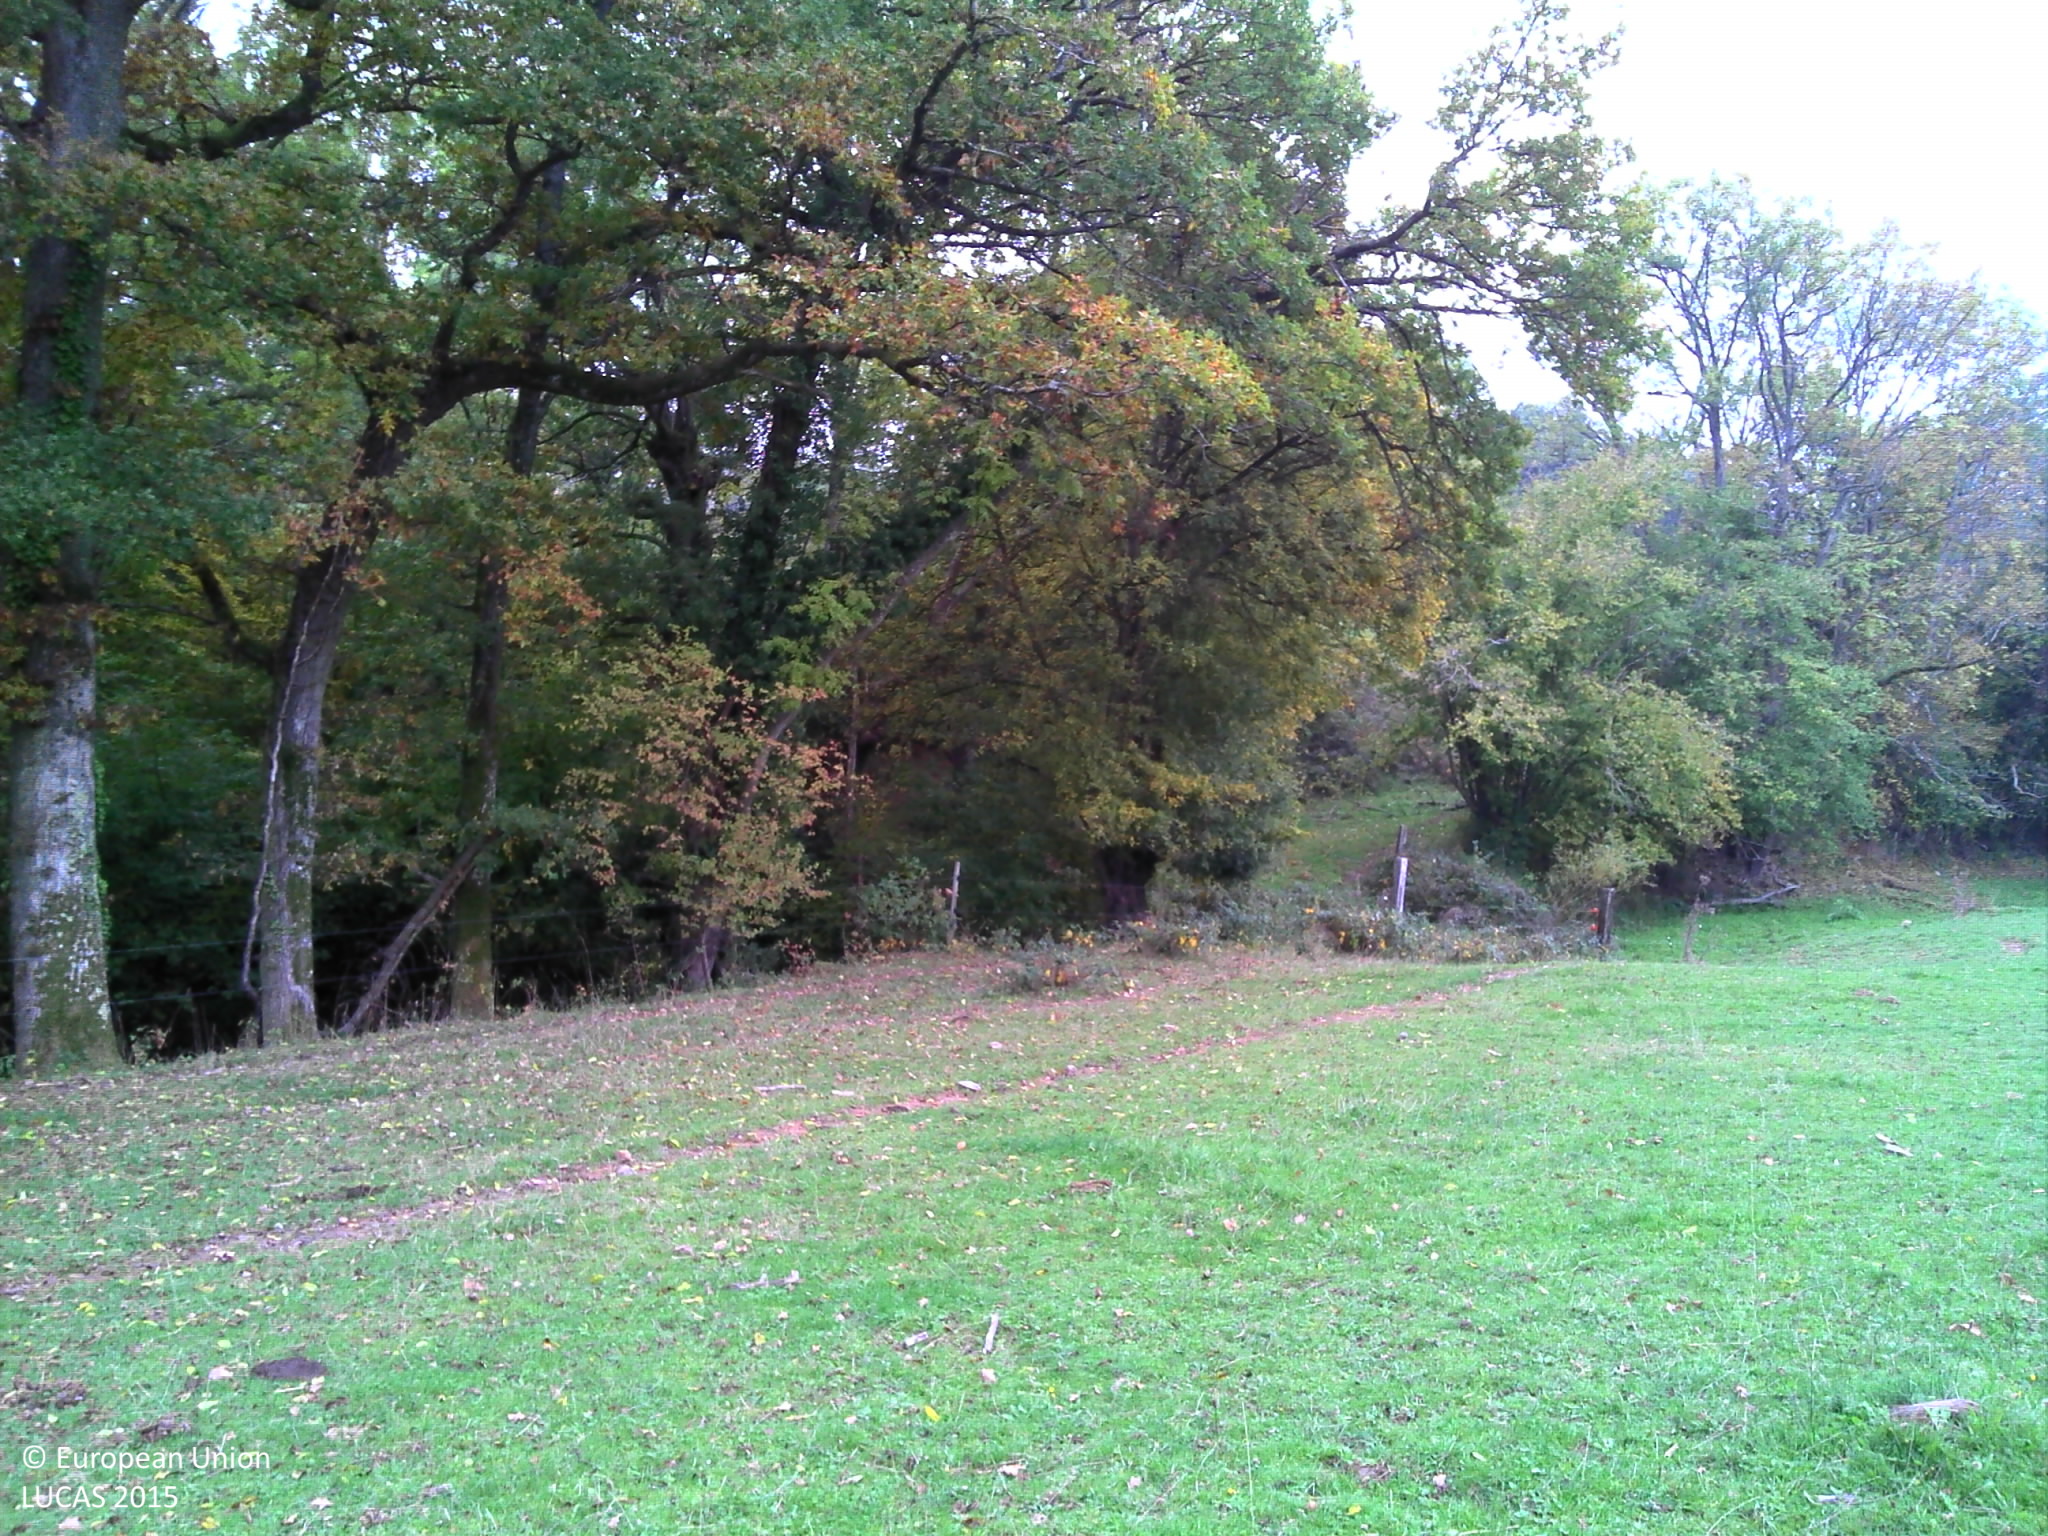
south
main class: Grassland
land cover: Grassland without tree/shrub cover
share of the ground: > 75 %
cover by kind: herbaceous plants 95 %, unconsolidated bare surface 5 %
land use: Agriculture (excluding fallow land and kitchen gardens)
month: October
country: FR
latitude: 45.9978
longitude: 3.0393
